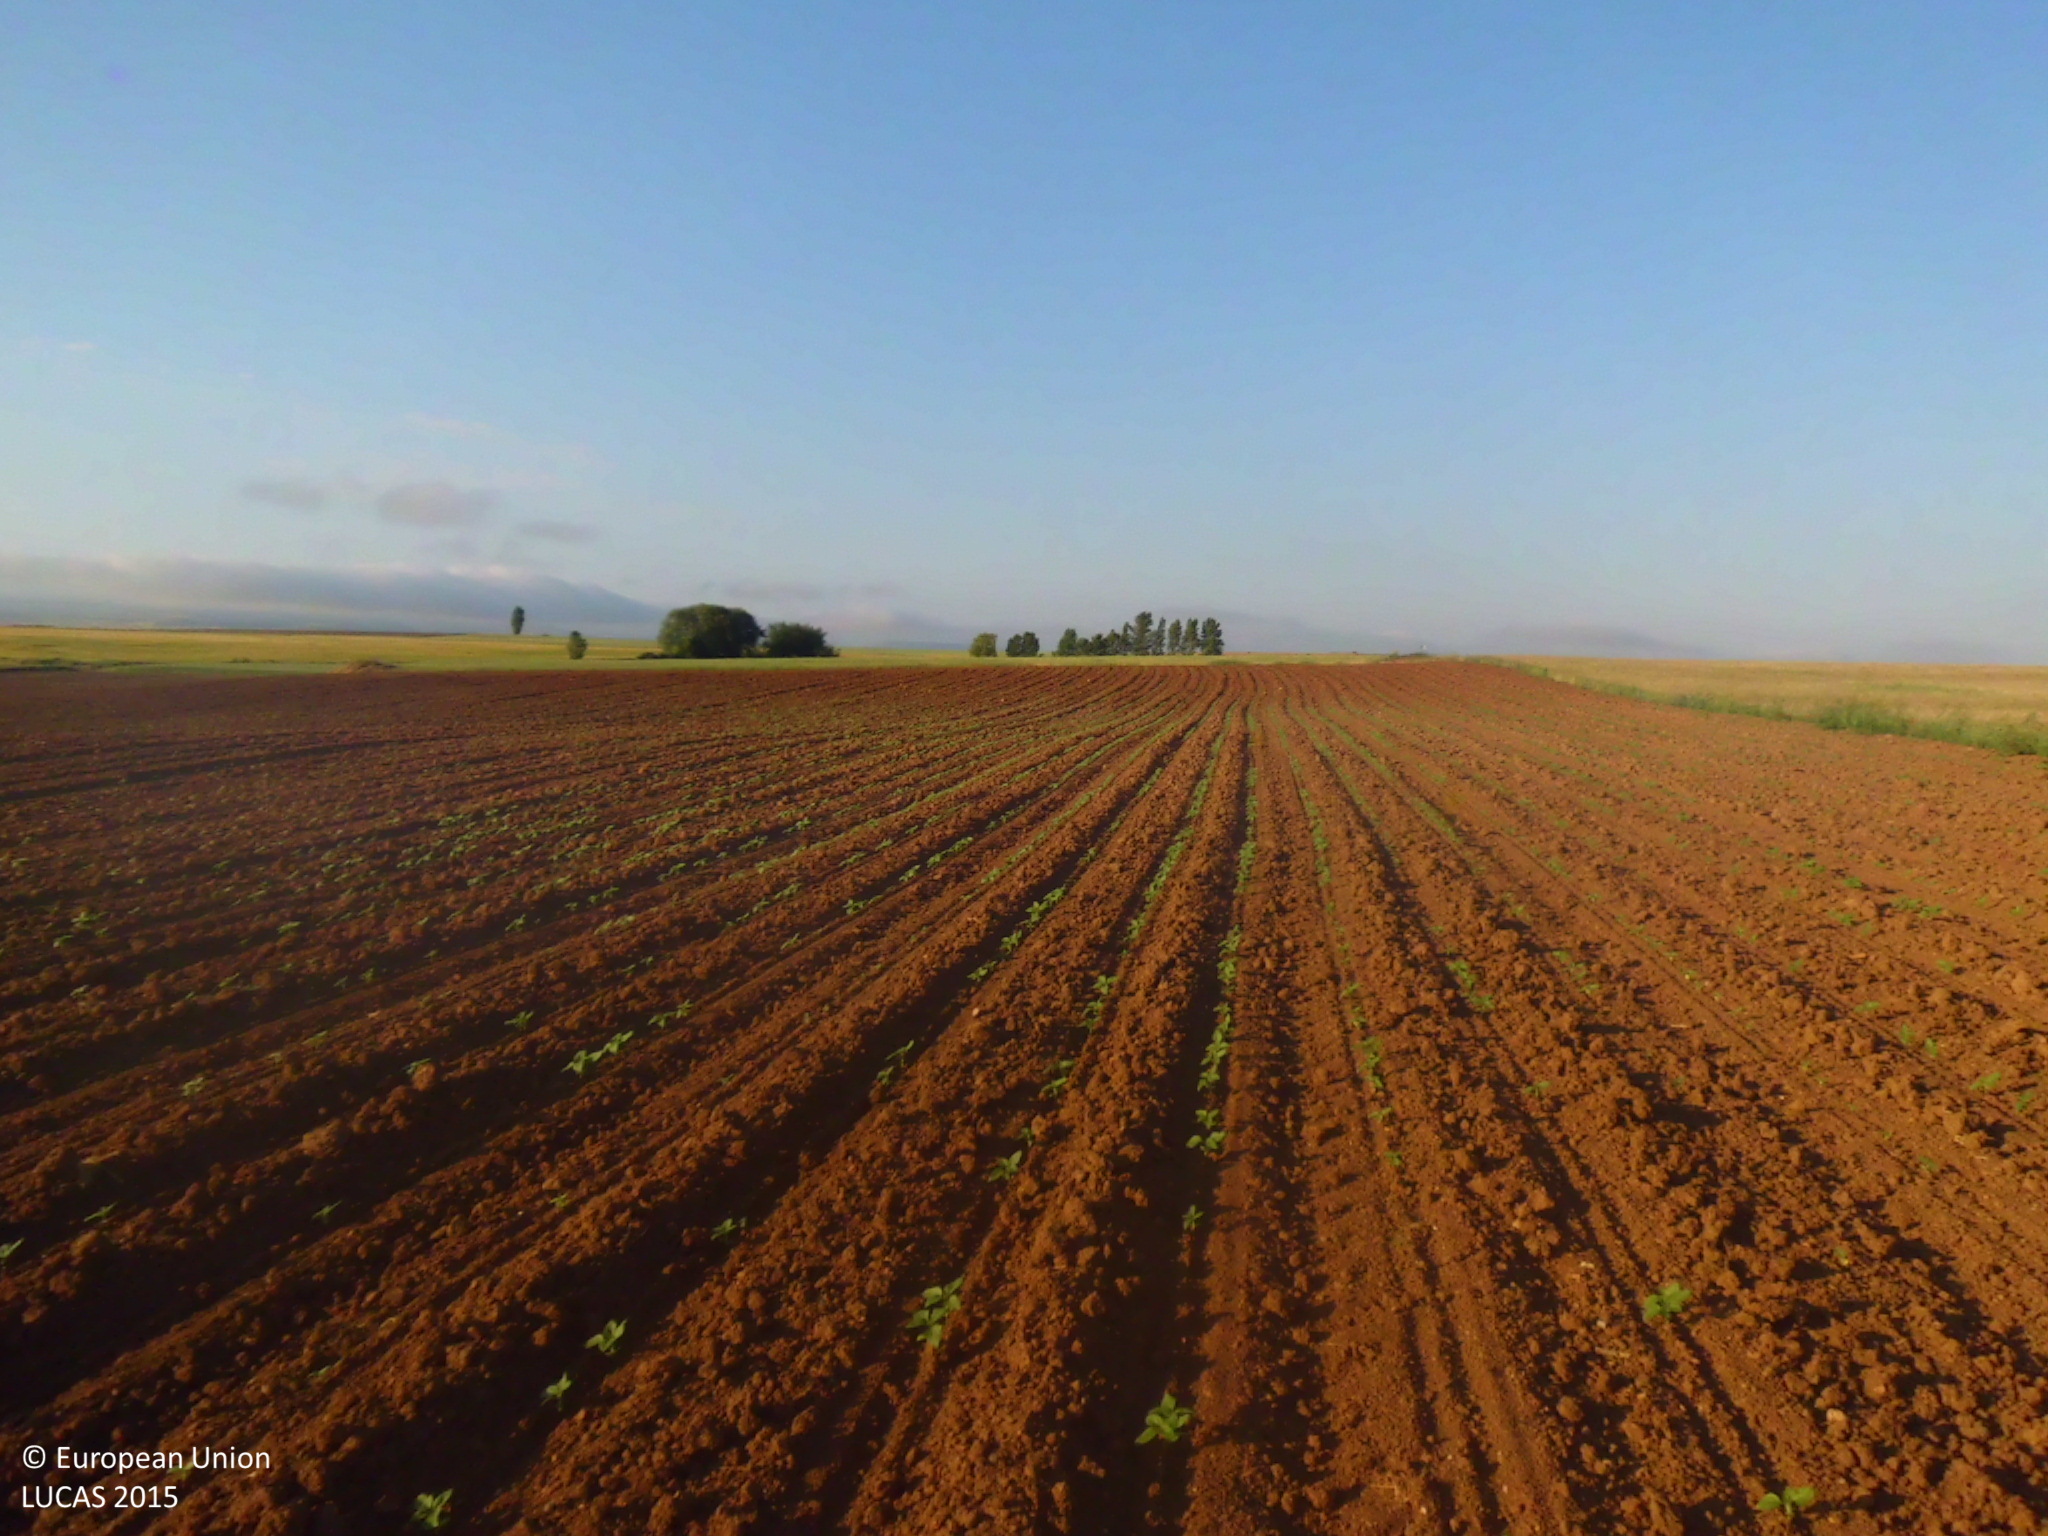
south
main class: Cropland
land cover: Sunflower
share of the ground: < 10 %
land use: Agriculture (excluding fallow land and kitchen gardens)
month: June
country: ES
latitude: 42.4931
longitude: -4.0478
